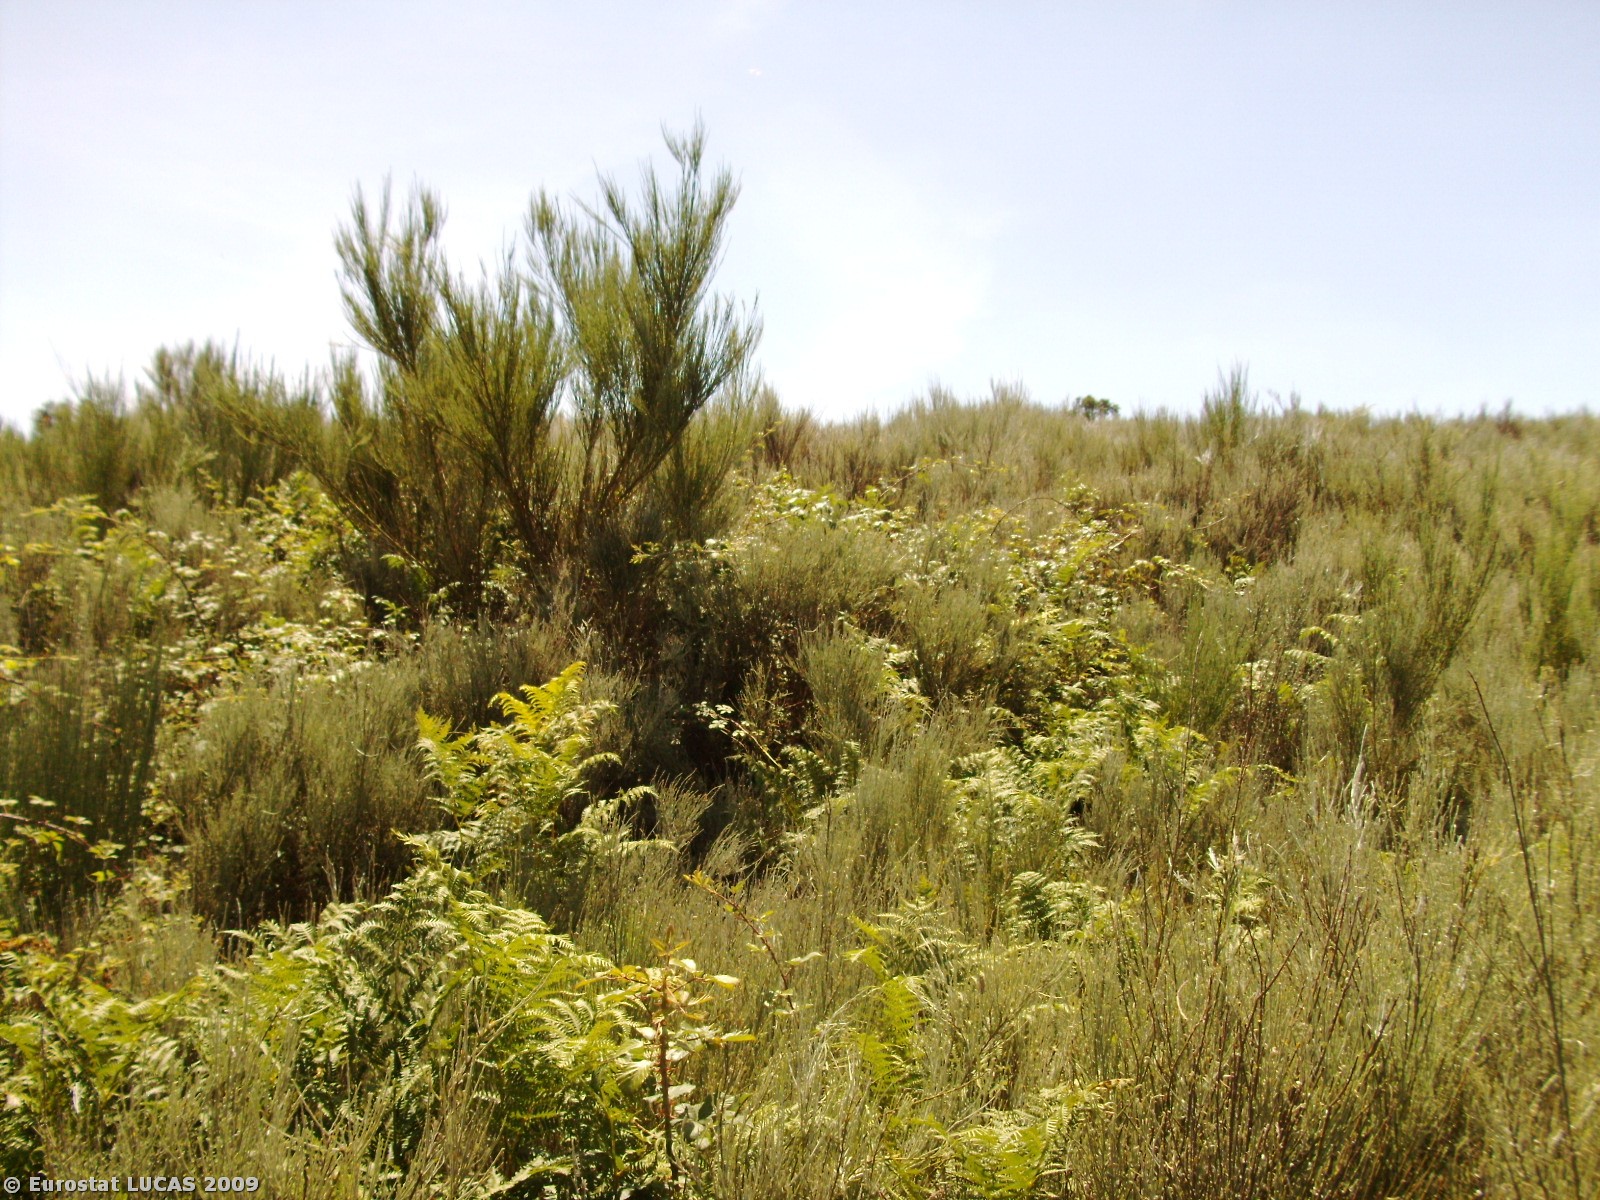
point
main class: Shrubland
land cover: Shrubland without tree cover
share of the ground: > 75 %
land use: Unused
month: July
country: PT
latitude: 40.5272
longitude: -7.5964
